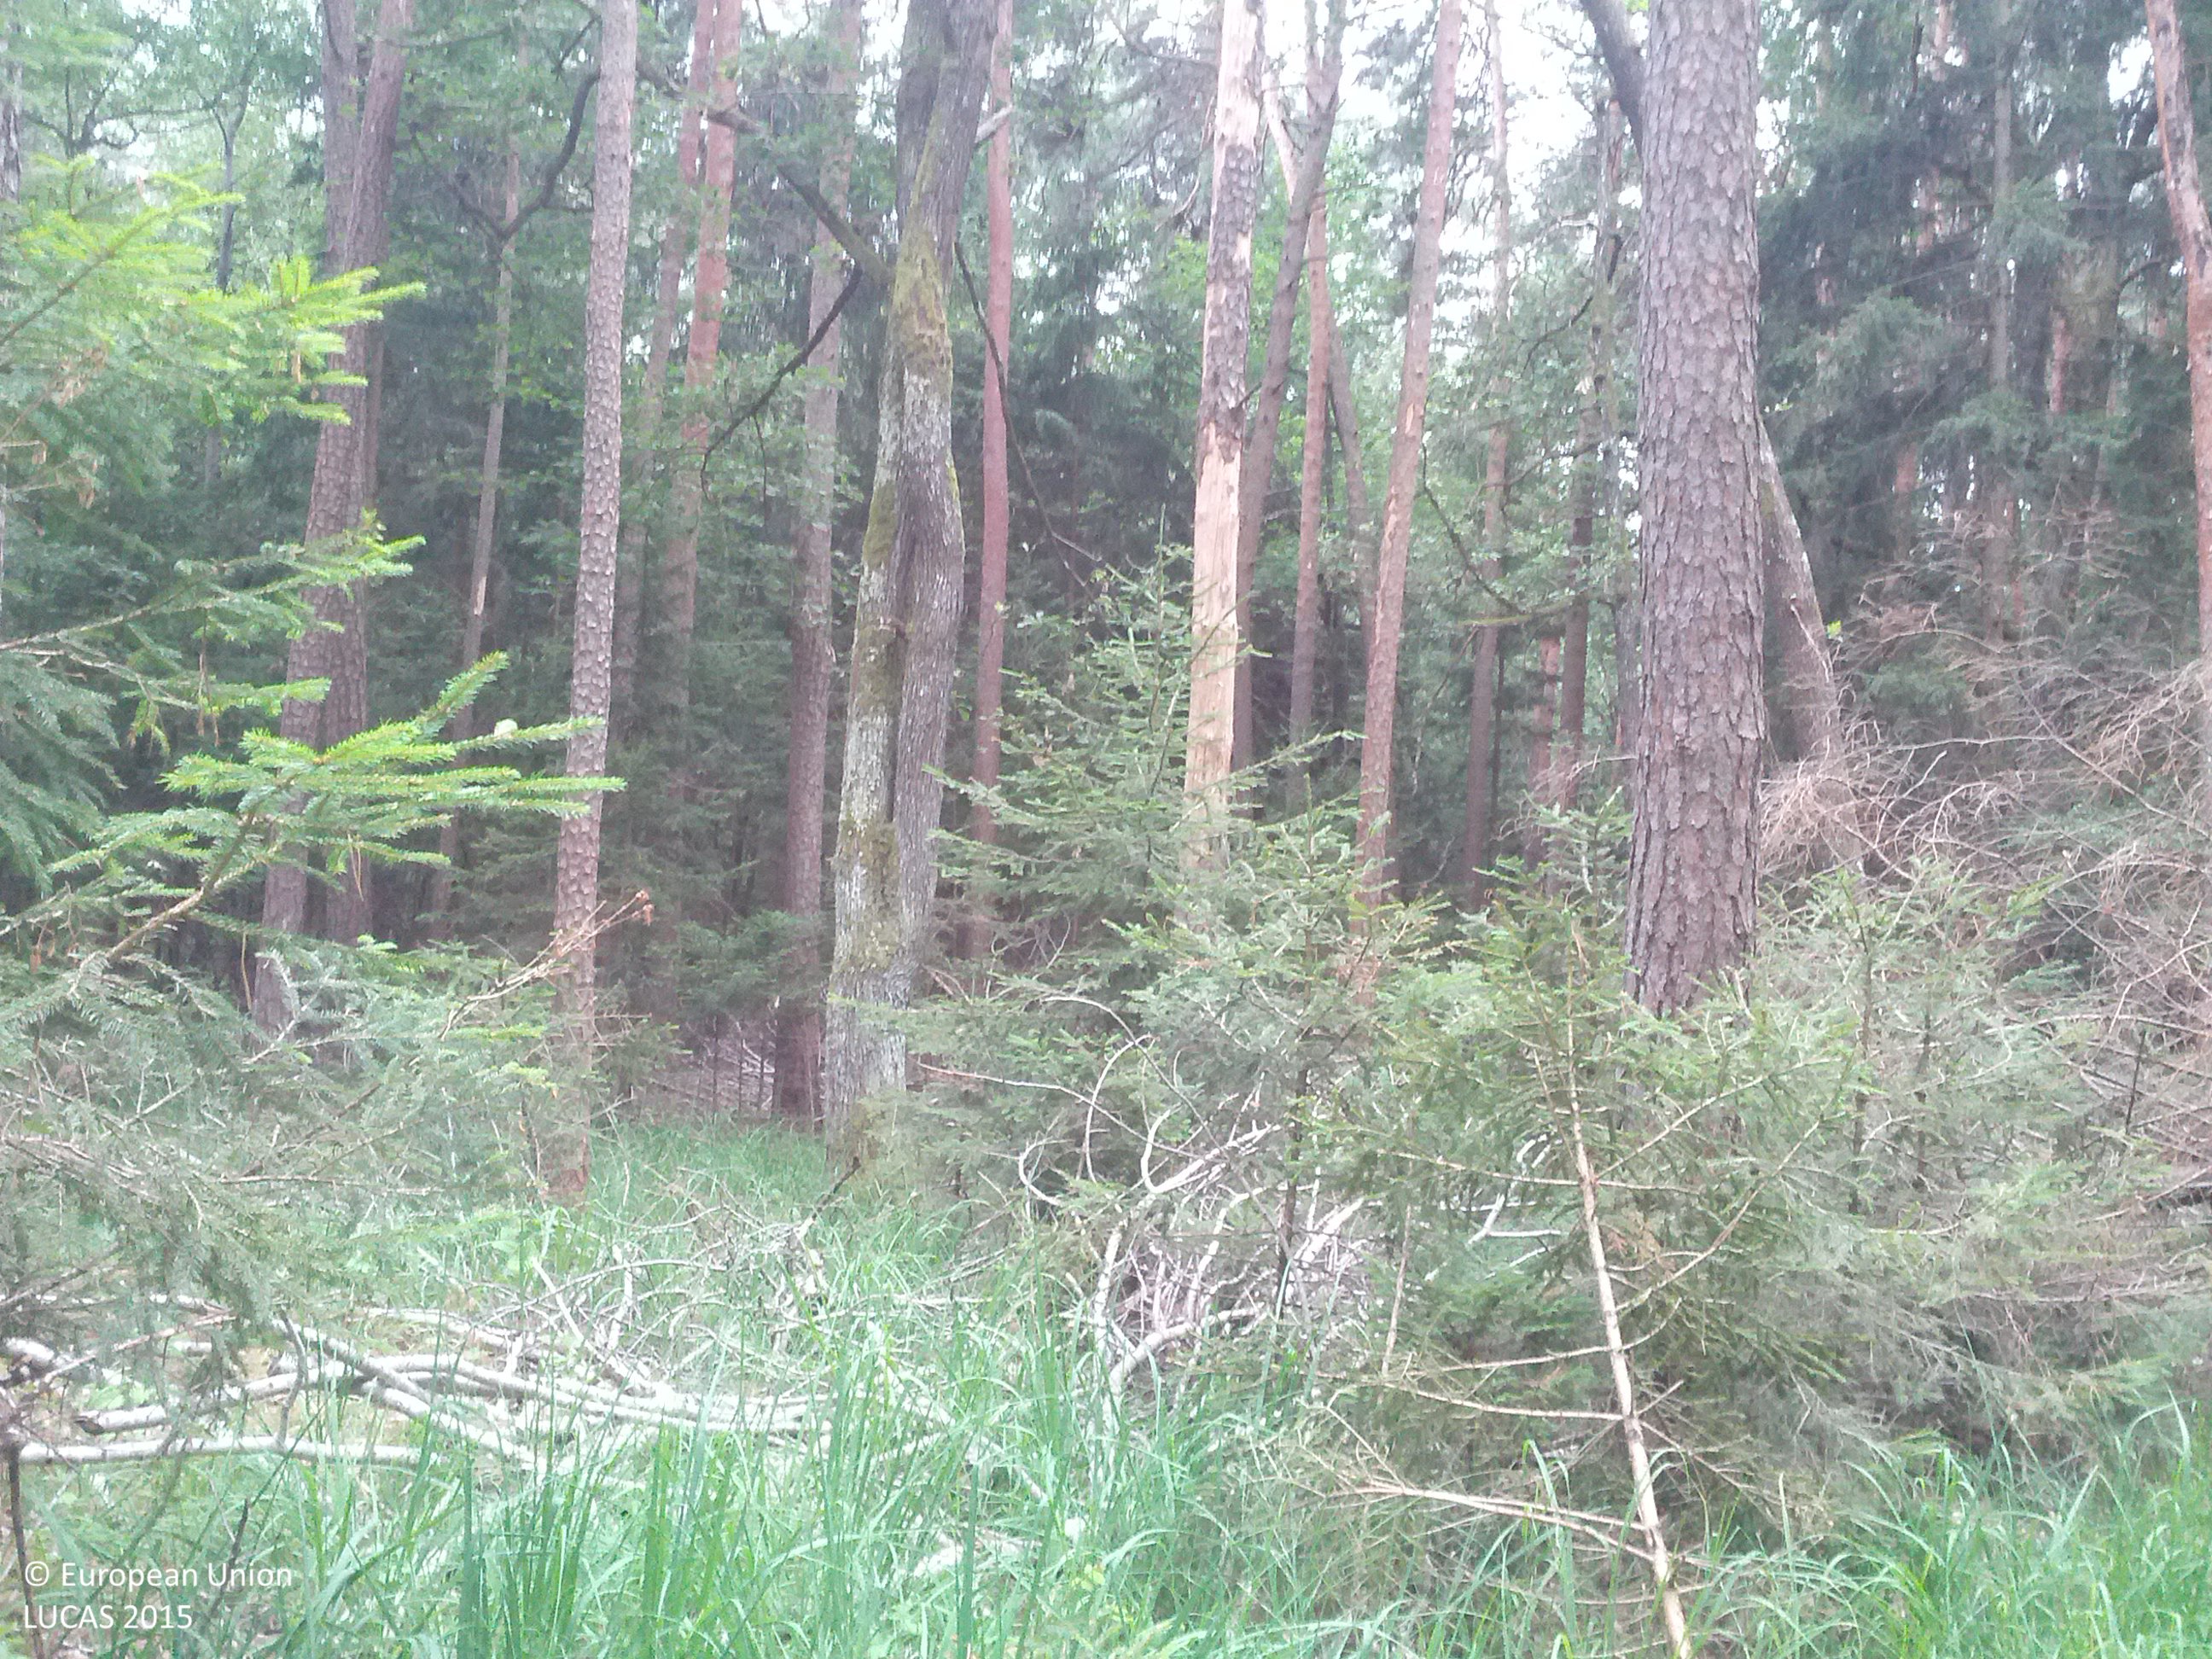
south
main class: Woodland
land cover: Pine dominated coniferous woodland
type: hemiboreal forest and nemoral coniferous forest and mixed broadleaved-coniferous forest
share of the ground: > 75 %
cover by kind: coniferous forest trees 80 %, herbaceous plants 15 %, unconsolidated bare surface 5 %
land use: Forestry
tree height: > 5 m
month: July
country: AT
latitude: 47.3475
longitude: 16.1575
